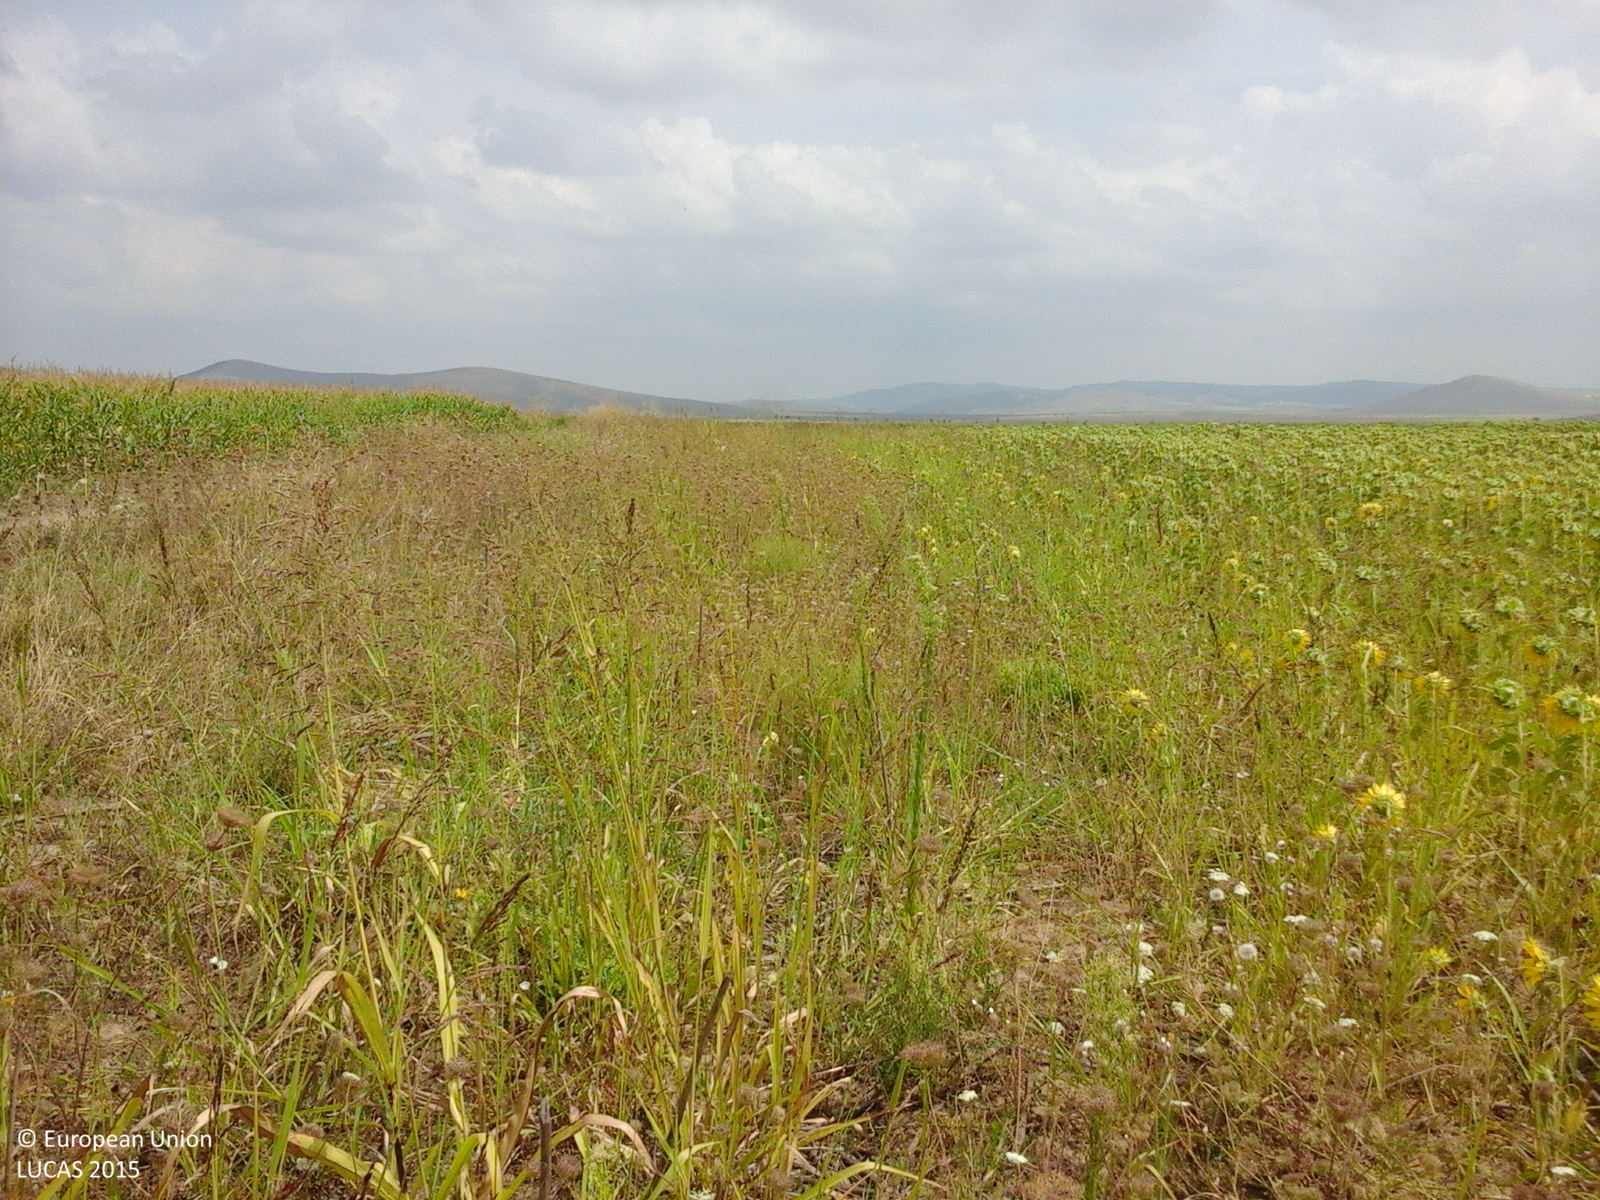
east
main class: Cropland
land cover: Sunflower
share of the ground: > 75 %
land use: Agriculture (excluding fallow land and kitchen gardens)
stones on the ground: < 10 %
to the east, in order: Sunflower
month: July
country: RO
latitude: 44.9861
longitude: 28.2441
